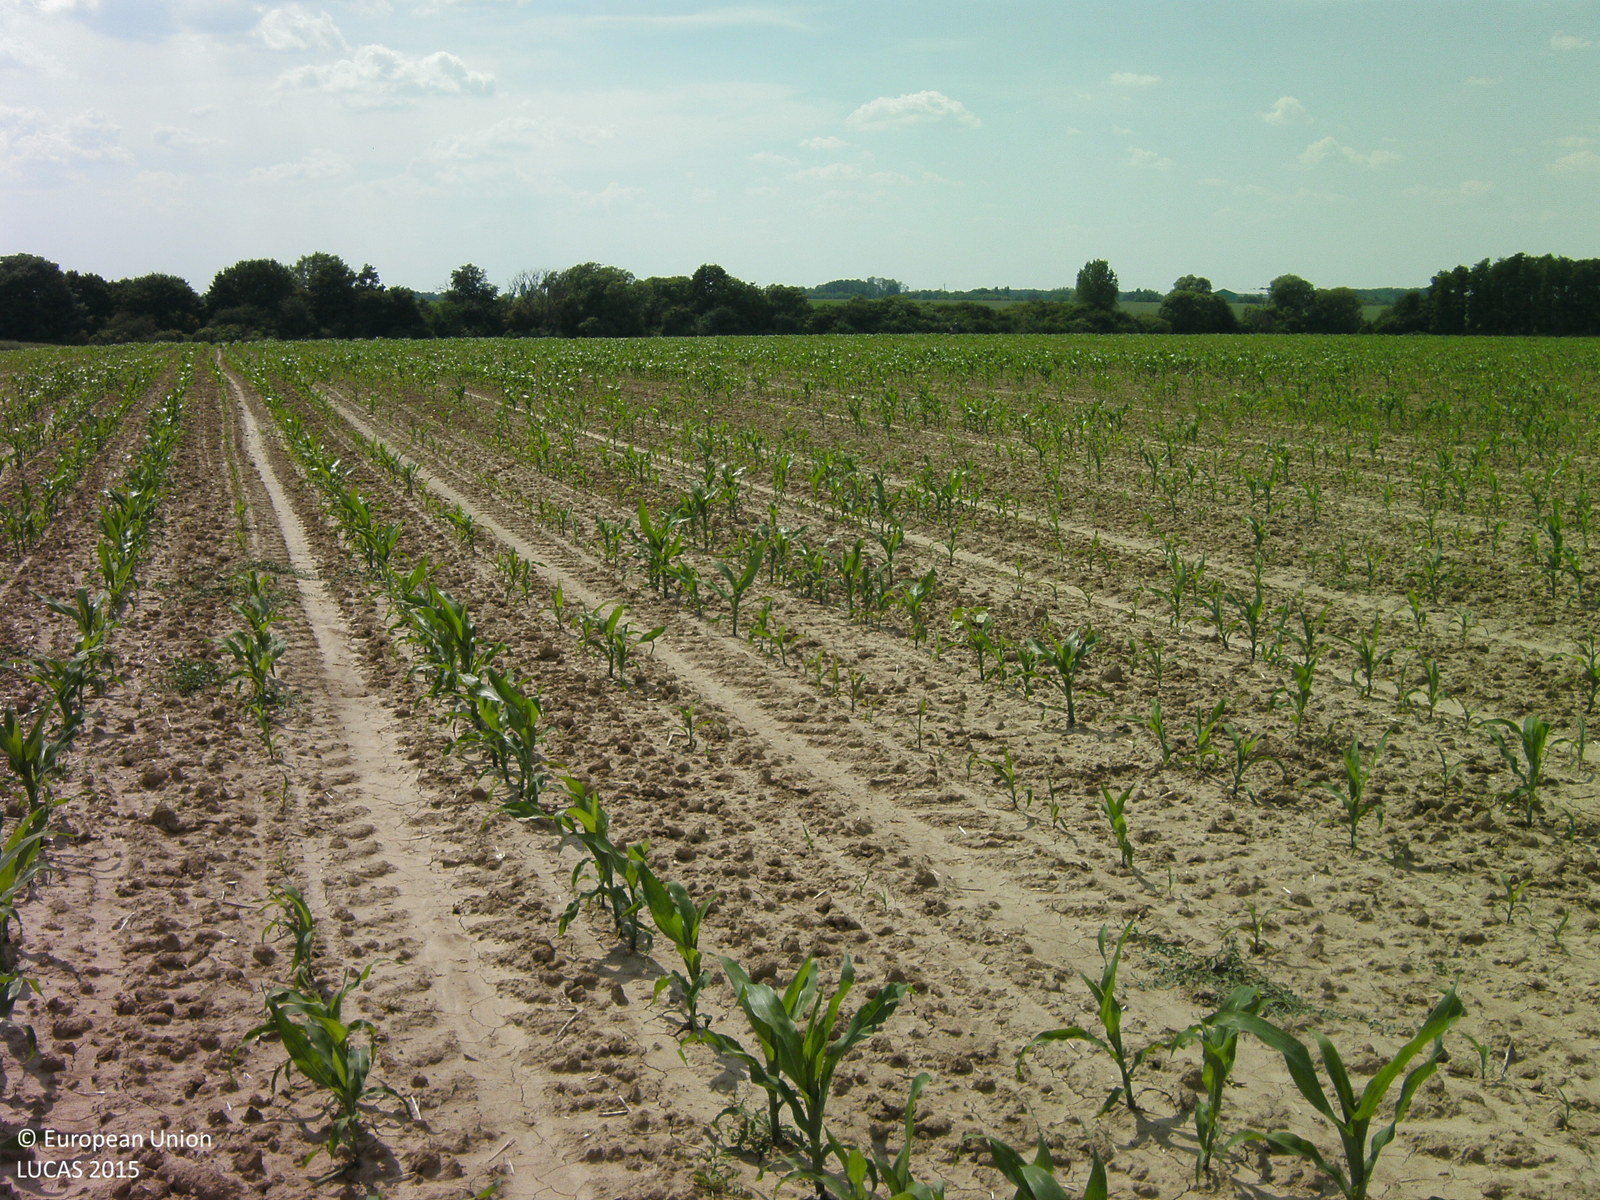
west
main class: Cropland
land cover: Maize
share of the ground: 10 - 25 %
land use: Agriculture (excluding fallow land and kitchen gardens)
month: June
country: HU
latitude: 46.4316
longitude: 17.7492
